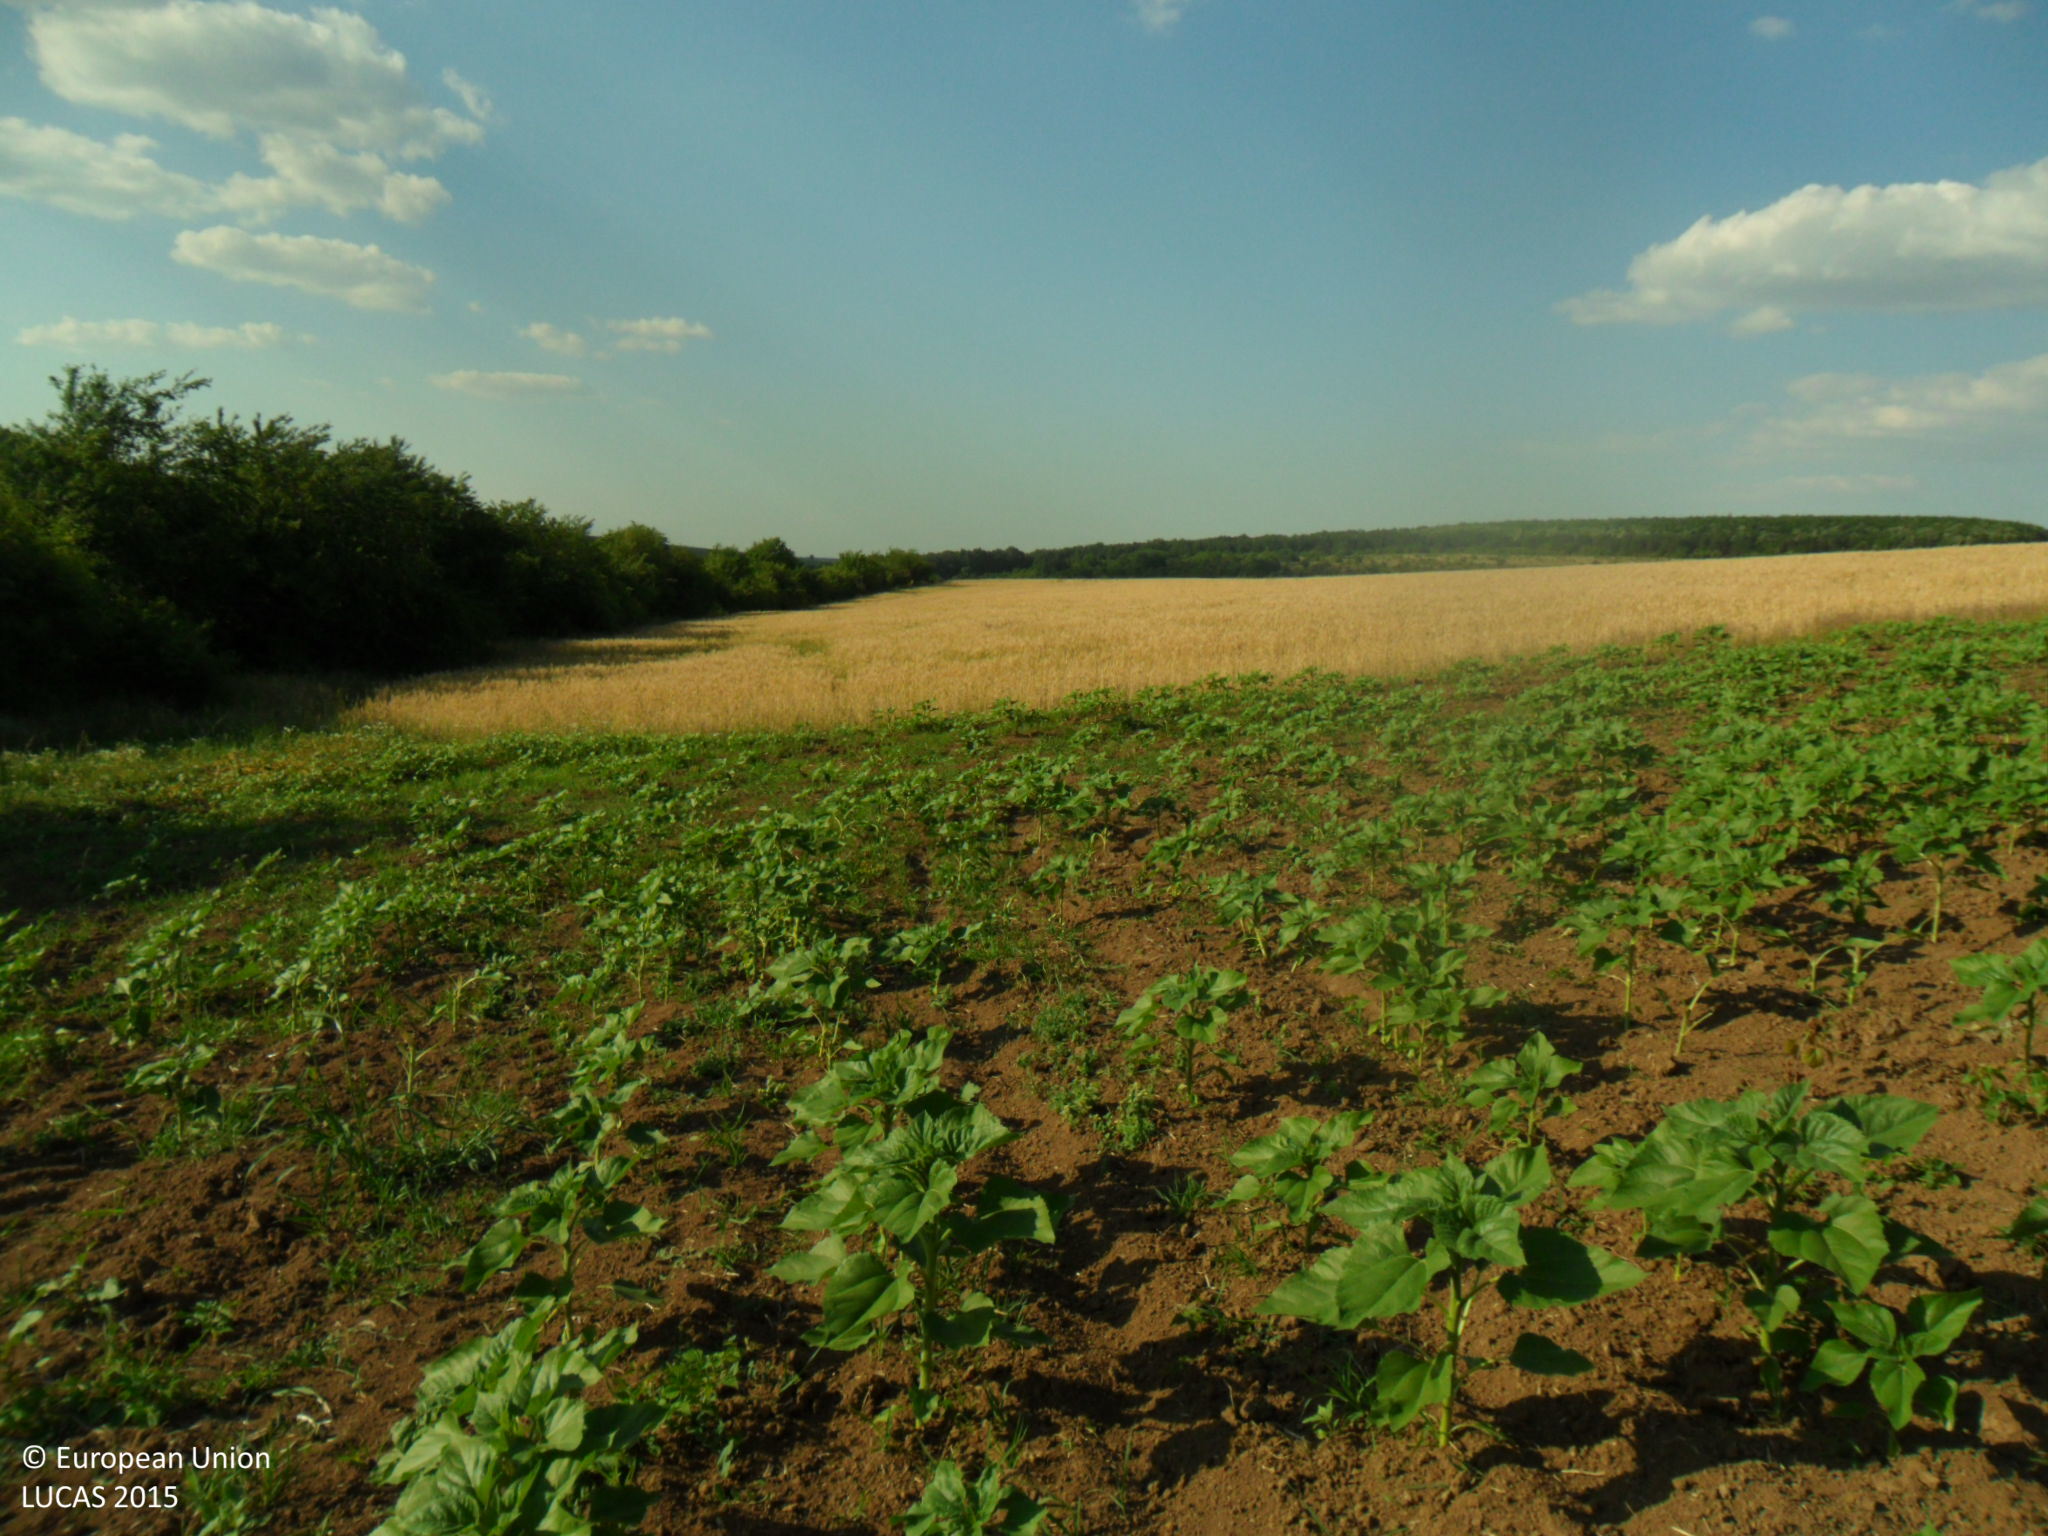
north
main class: Cropland
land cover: Sunflower
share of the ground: 50 - 75 %
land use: Agriculture (excluding fallow land and kitchen gardens)
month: June
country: BG
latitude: 43.5083
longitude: 26.8744
